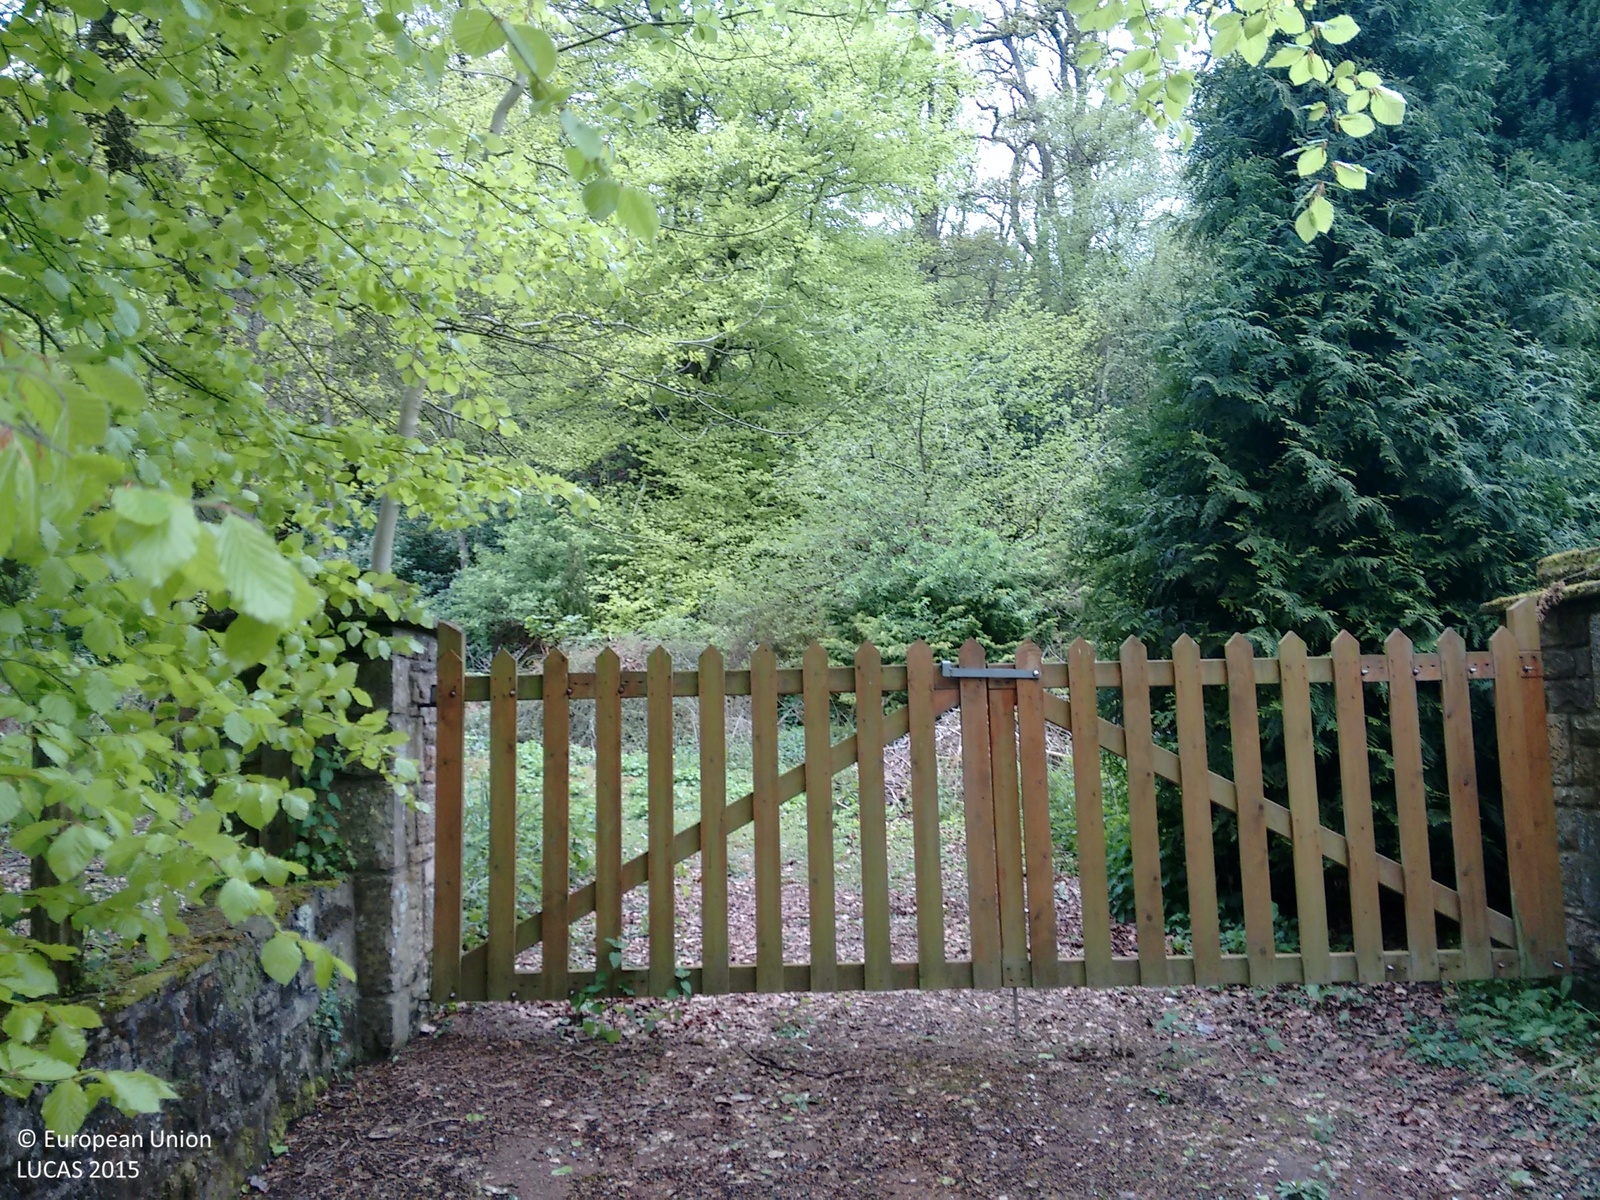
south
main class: Woodland
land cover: Other mixed woodland
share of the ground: > 75 %
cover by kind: coniferous forest trees 50 %, broadleaved forest trees 50 %
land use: Forestry
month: May
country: GB
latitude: 54.0736
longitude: -2.7380
